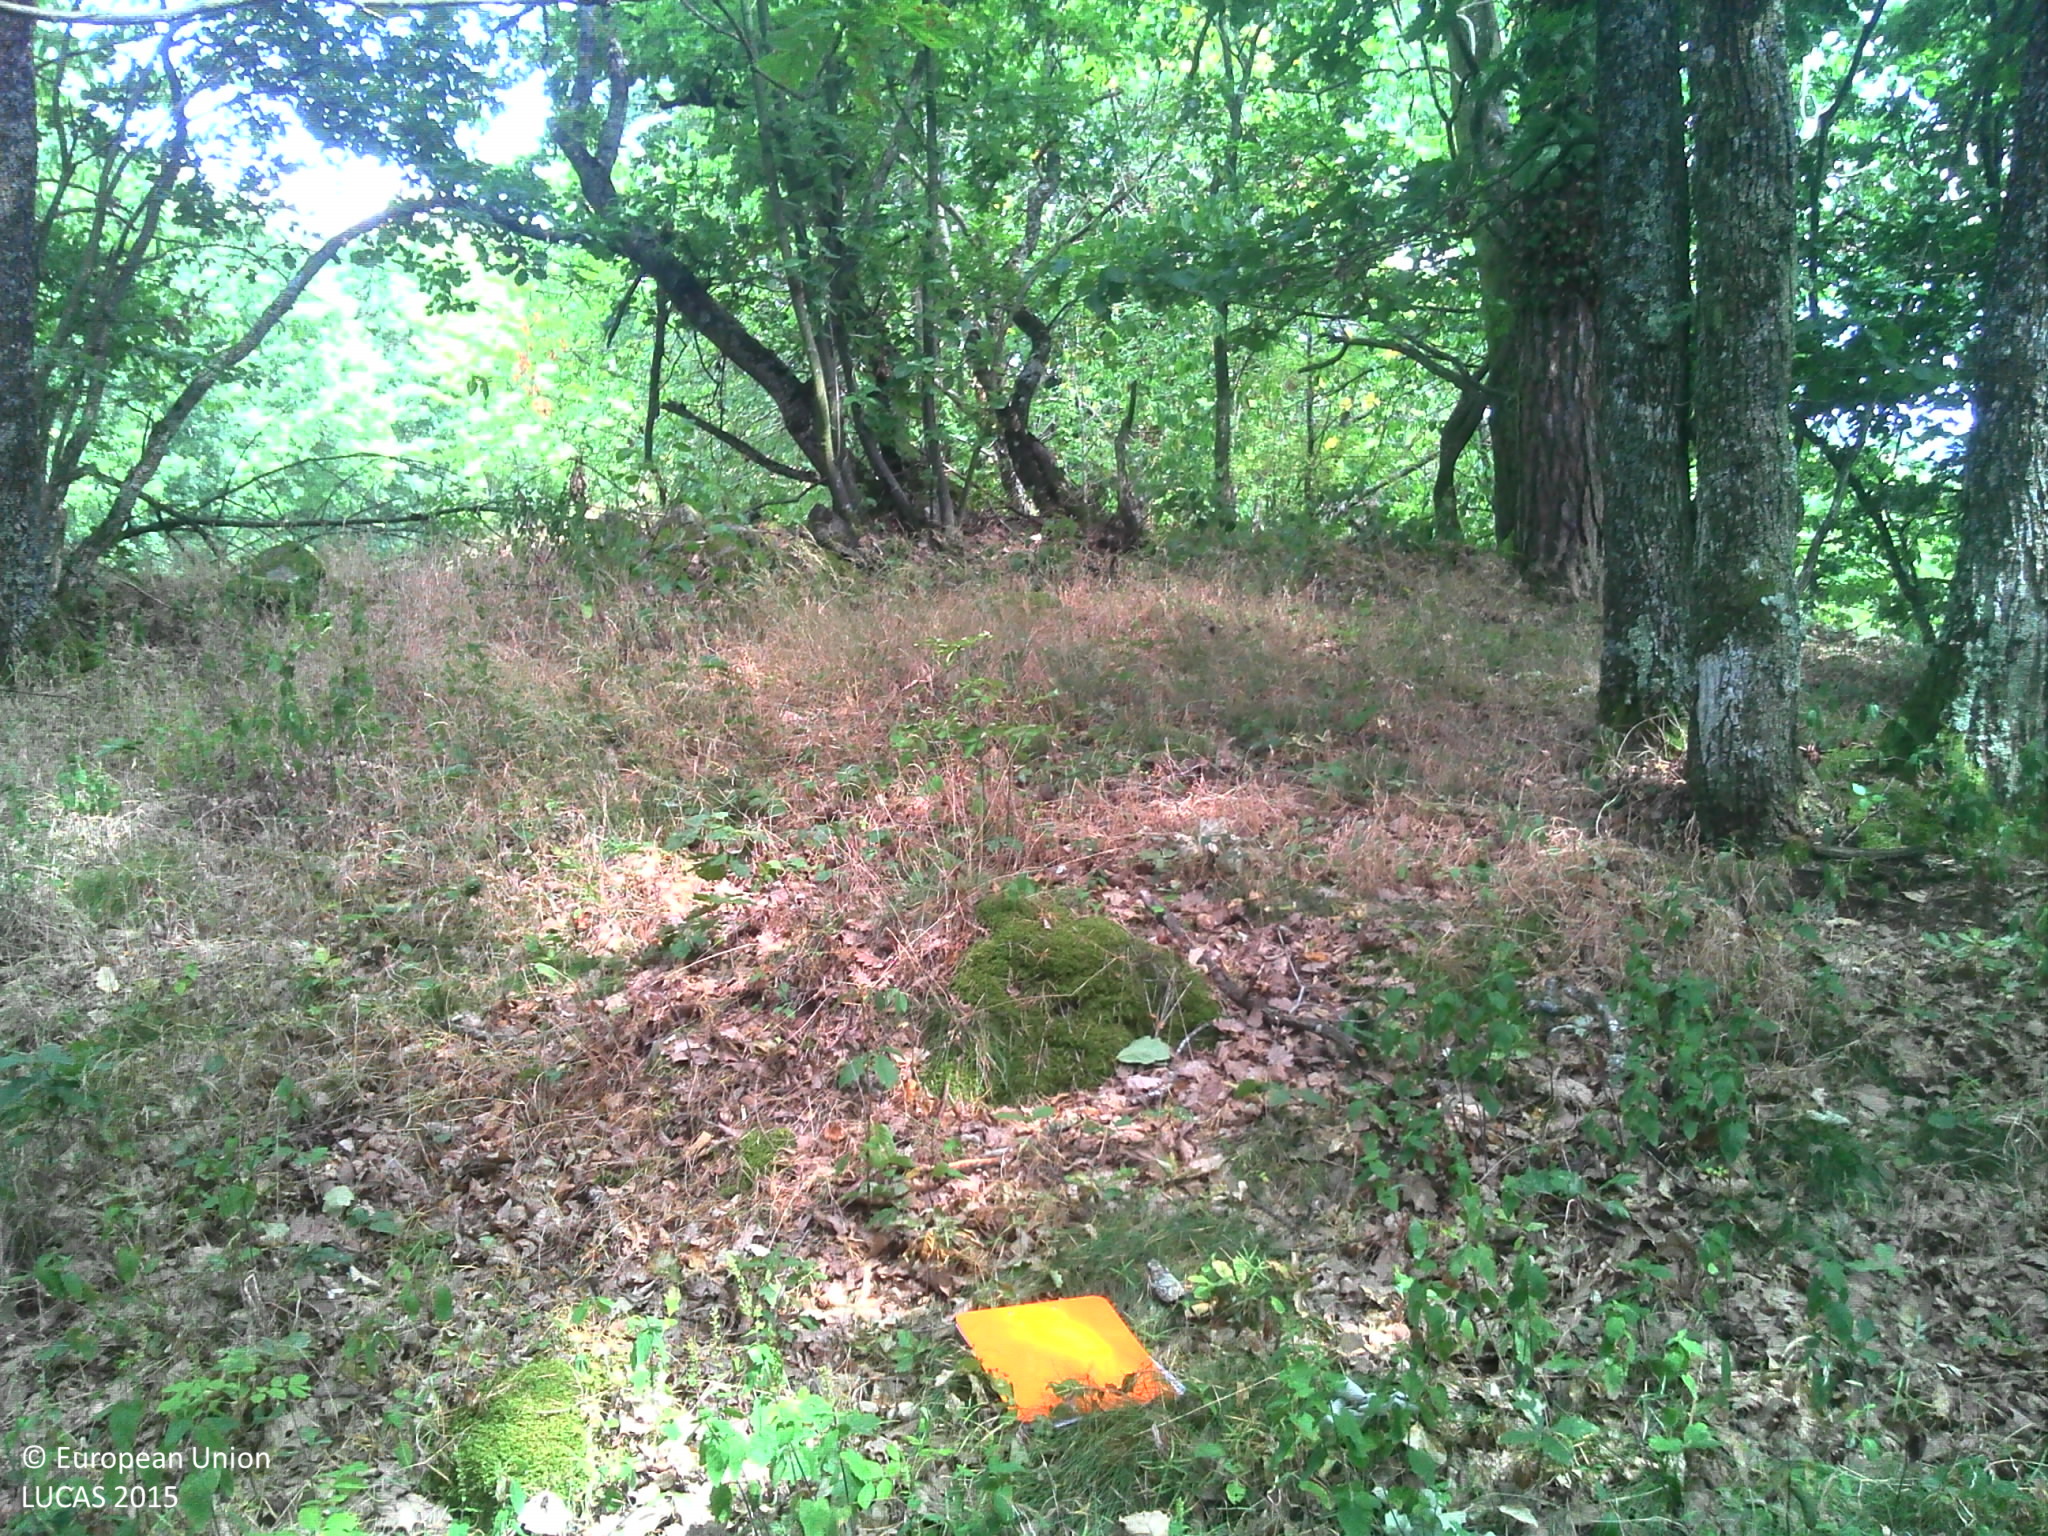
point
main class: Woodland
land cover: Broadleaved woodland
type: acidophilous oak and oak-birch forest
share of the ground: > 75 %
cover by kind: broadleaved forest trees 80 %, herbaceous plants 20 %
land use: Forestry
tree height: > 5 m
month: July
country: FR
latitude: 45.7204
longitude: 4.4657
